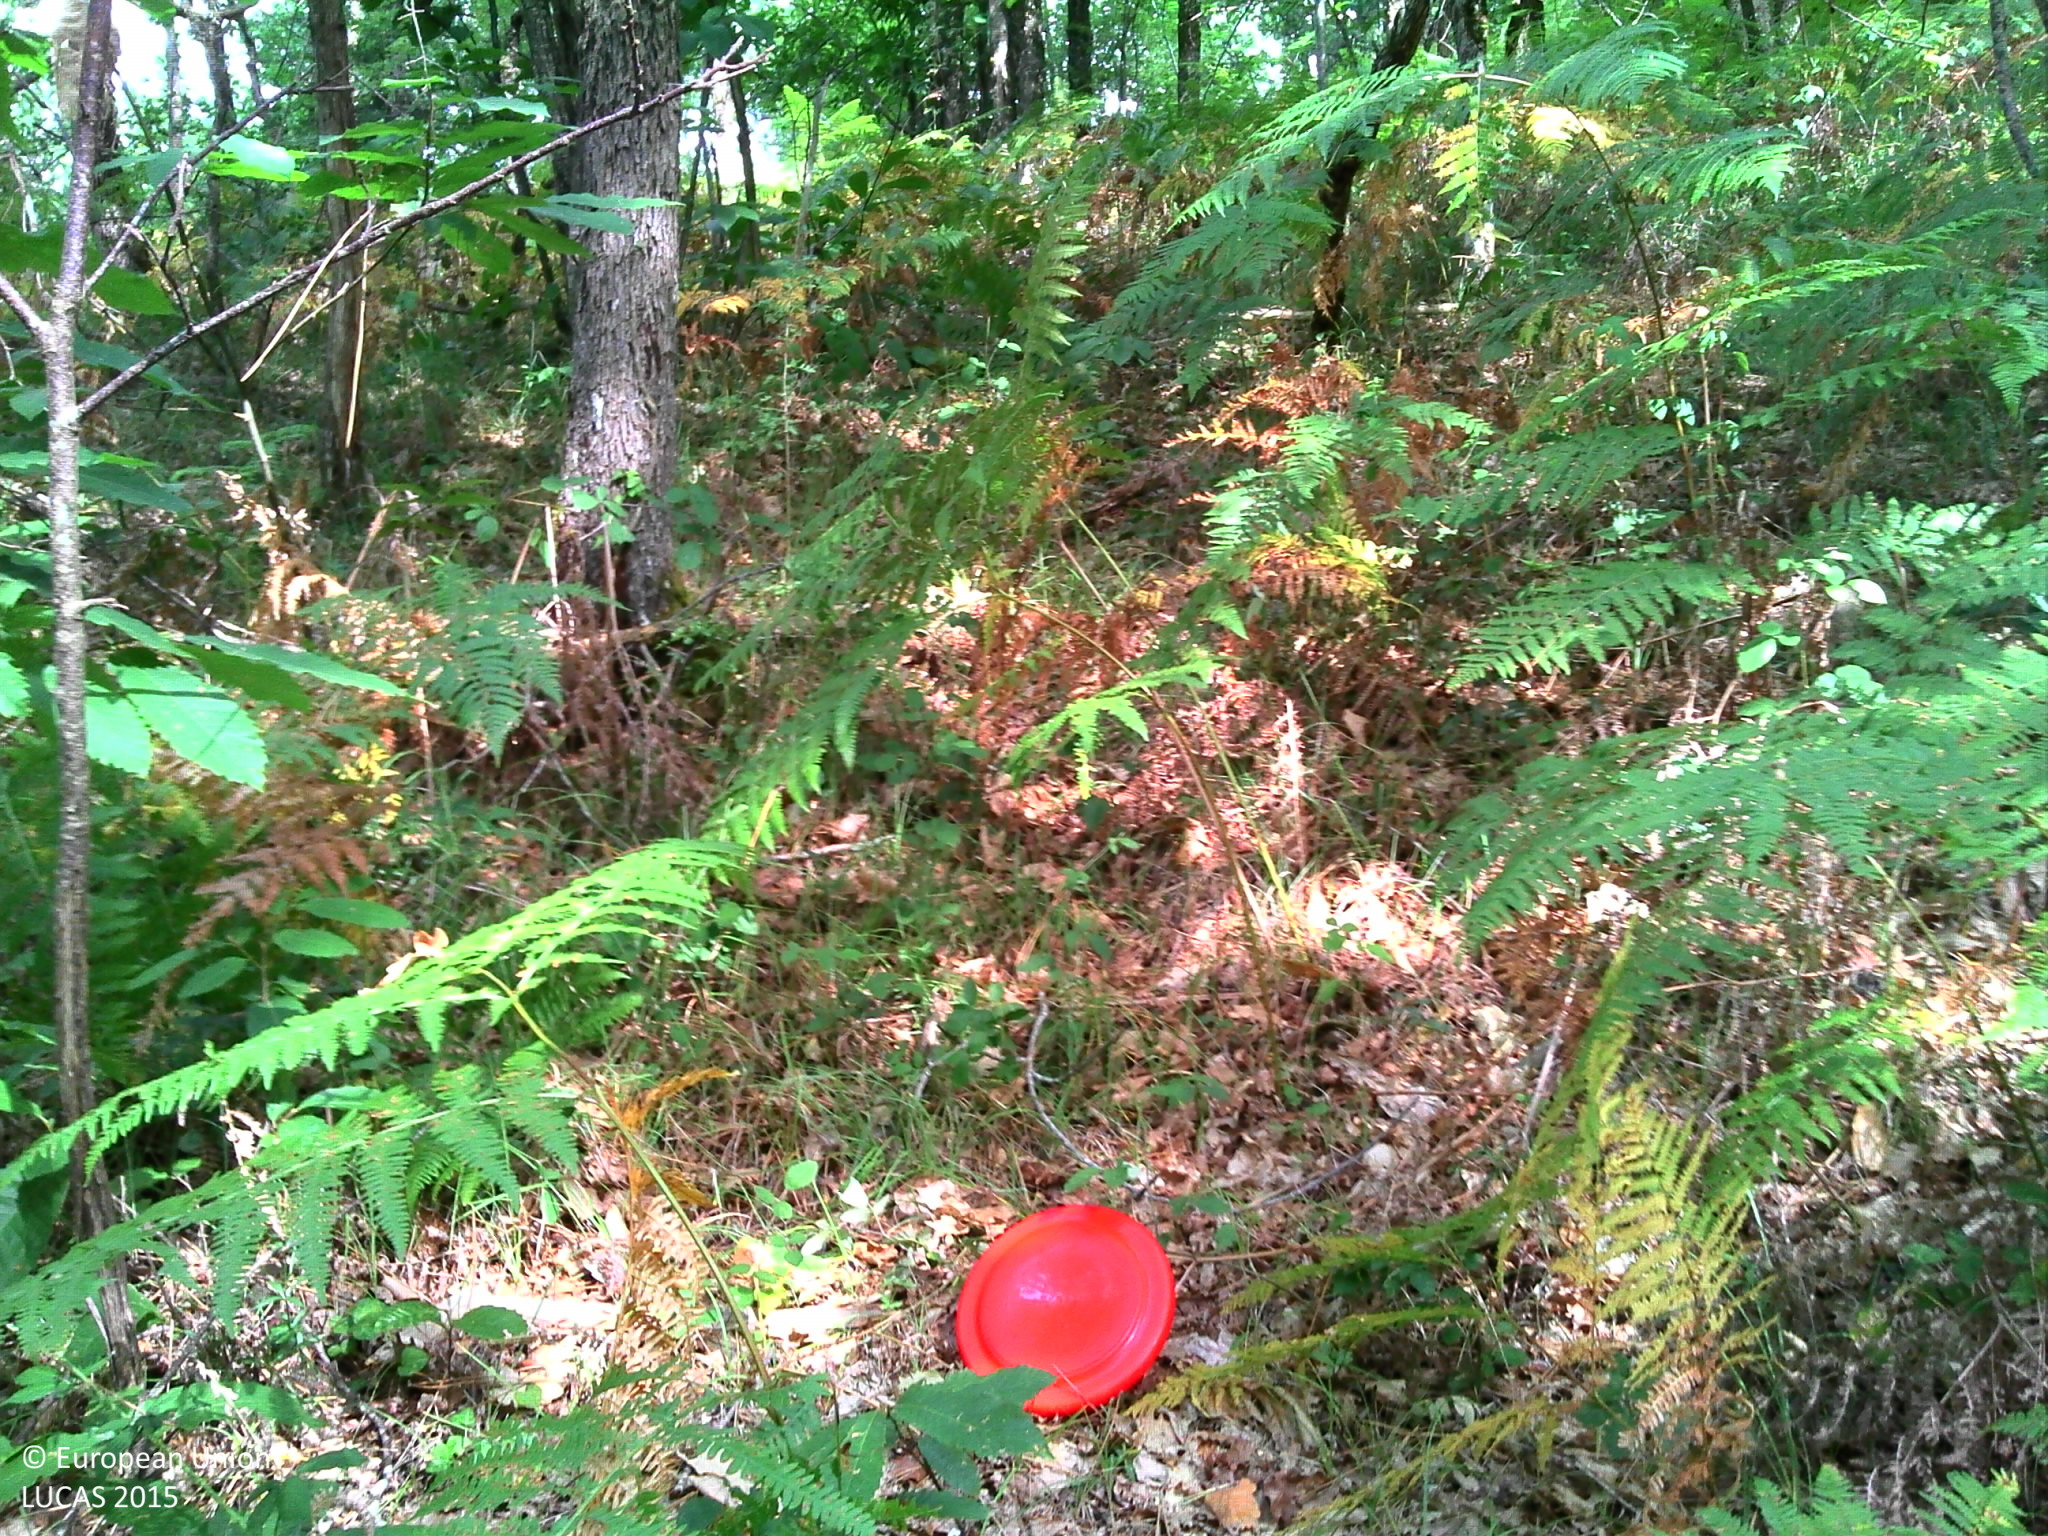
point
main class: Woodland
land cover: Broadleaved woodland
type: thermophilous deciduous forest
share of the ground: > 75 %
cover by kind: broadleaved forest trees 75 %, shrubs 10 %, herbaceous plants 10 %, lichens and mosses 5 %
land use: Forestry
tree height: > 5 m
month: July
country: FR
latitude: 45.0569
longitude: 1.1172
